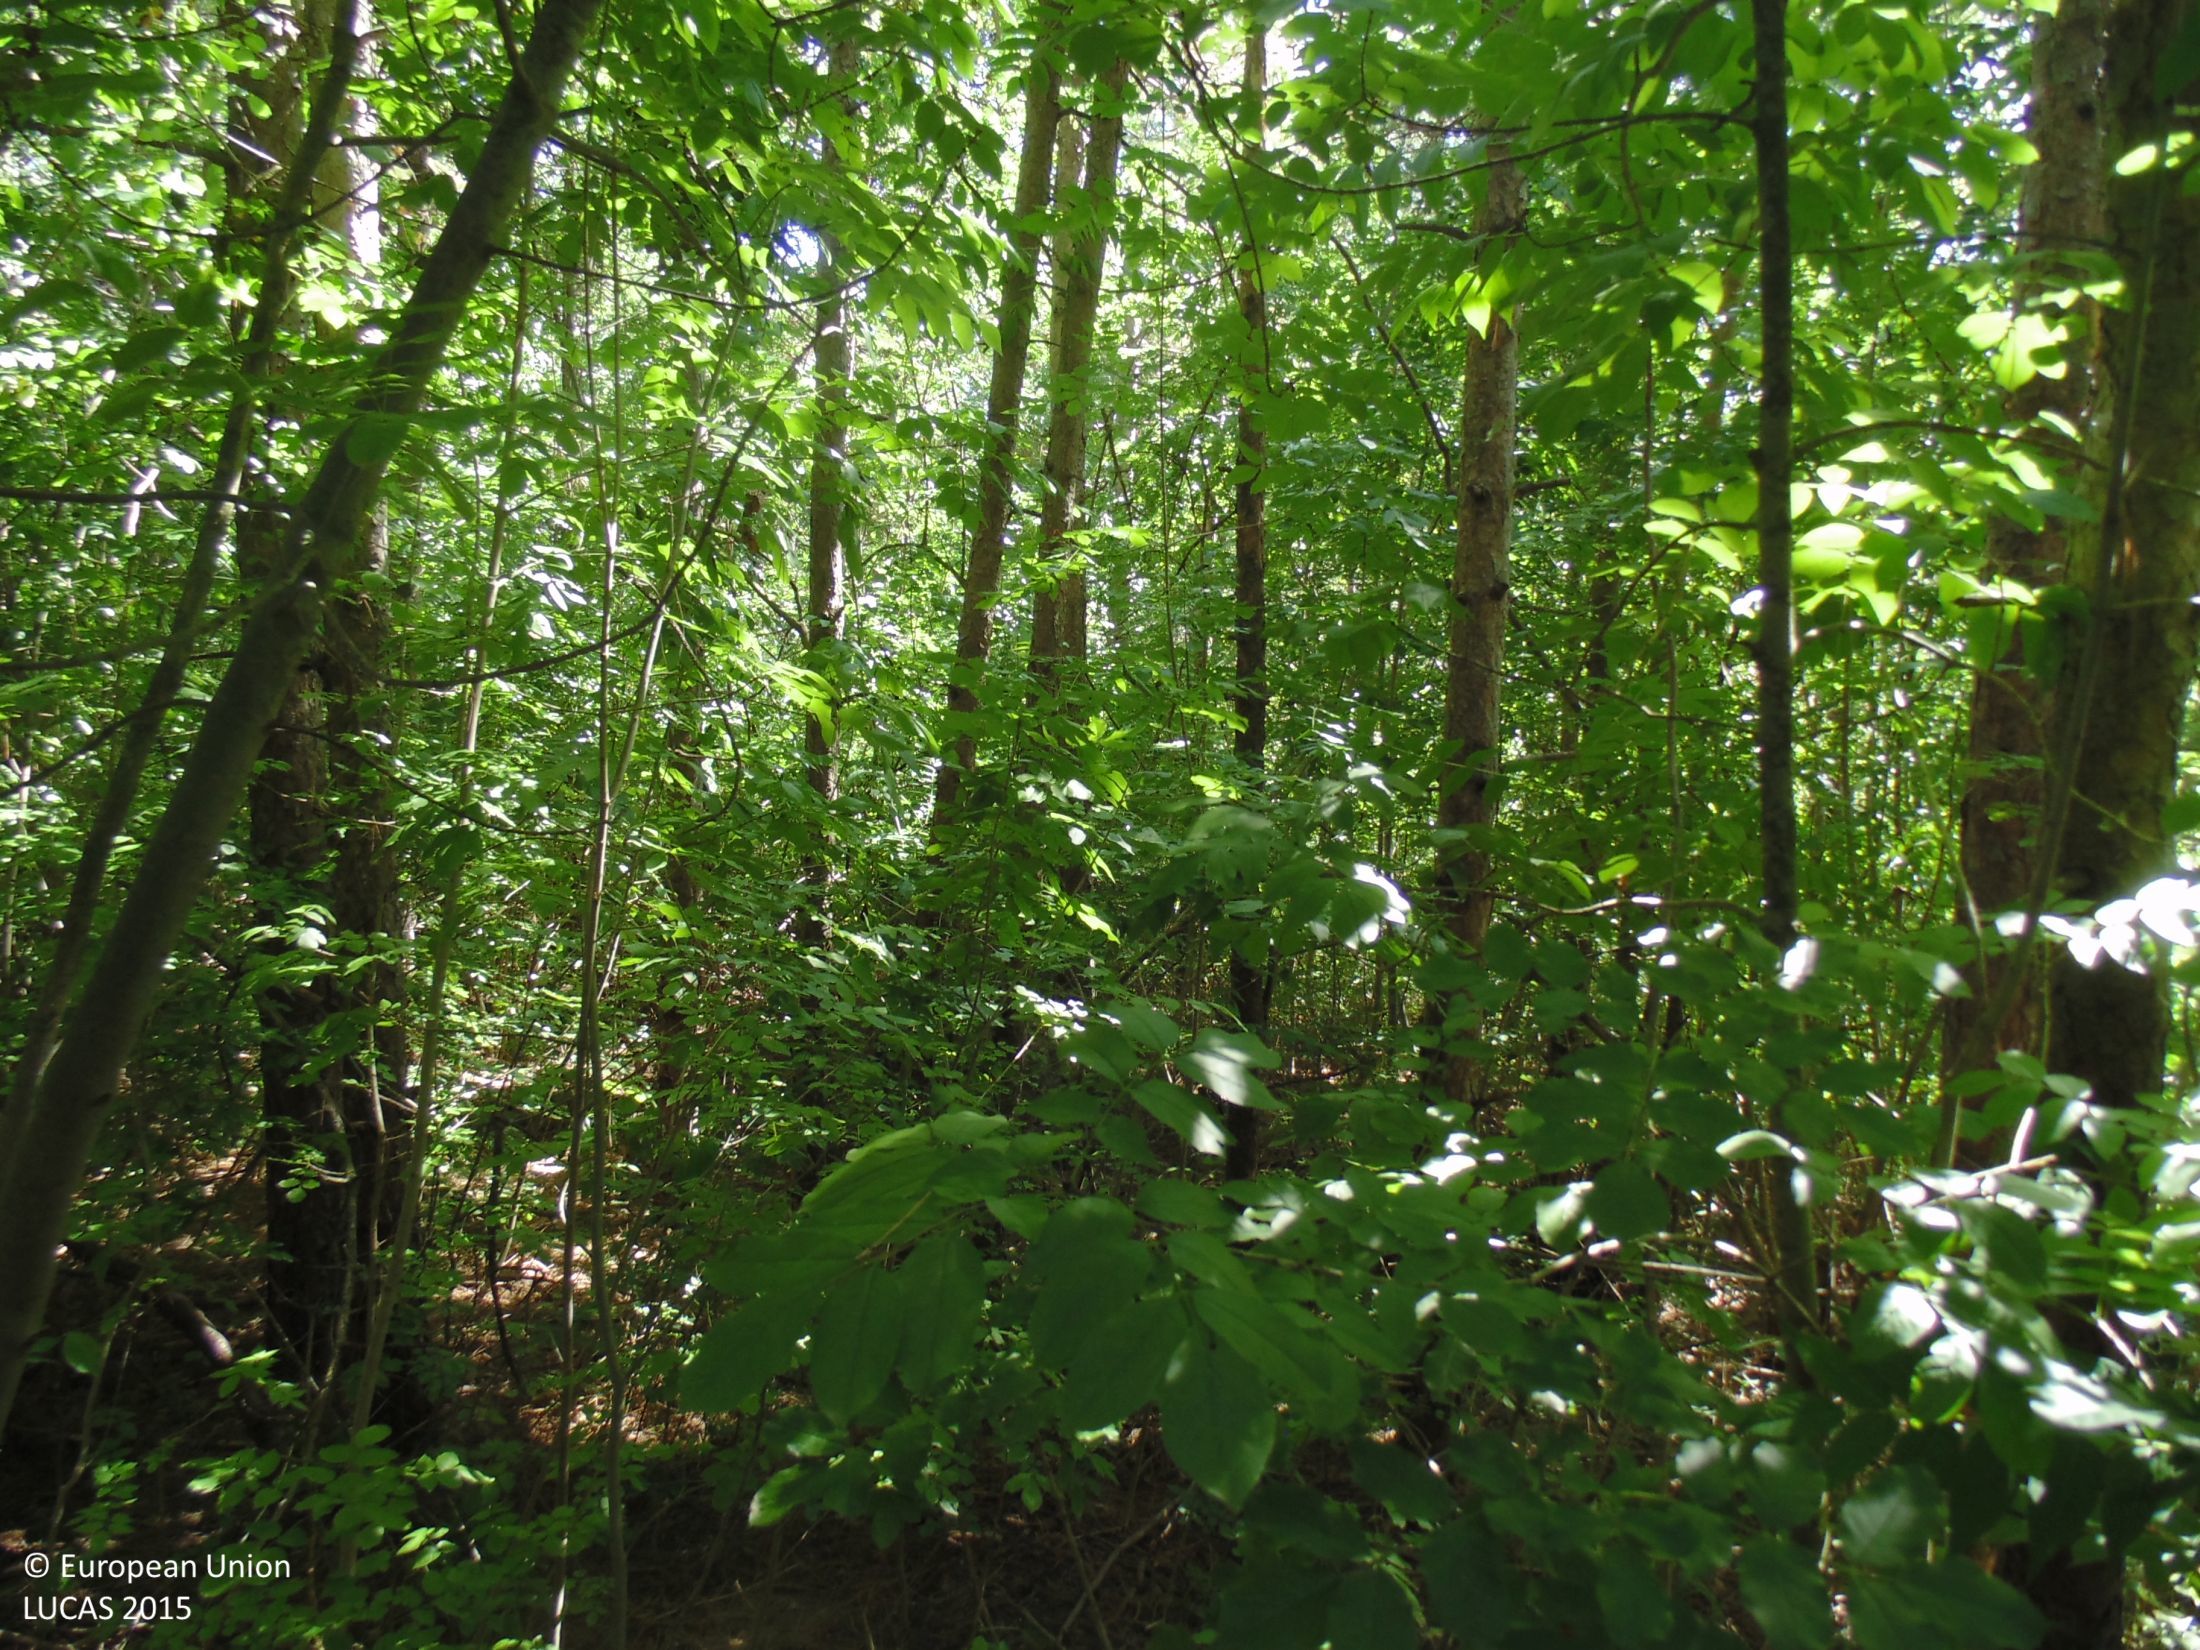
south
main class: Woodland
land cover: Pine dominated coniferous woodland
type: hemiboreal forest and nemoral coniferous forest and mixed broadleaved-coniferous forest
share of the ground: > 75 %
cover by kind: coniferous forest trees 85 %, shrubs 10 %, herbaceous plants 5 %
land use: Forestry
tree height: > 5 m
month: July
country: BG
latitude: 43.4173
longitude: 28.1437
